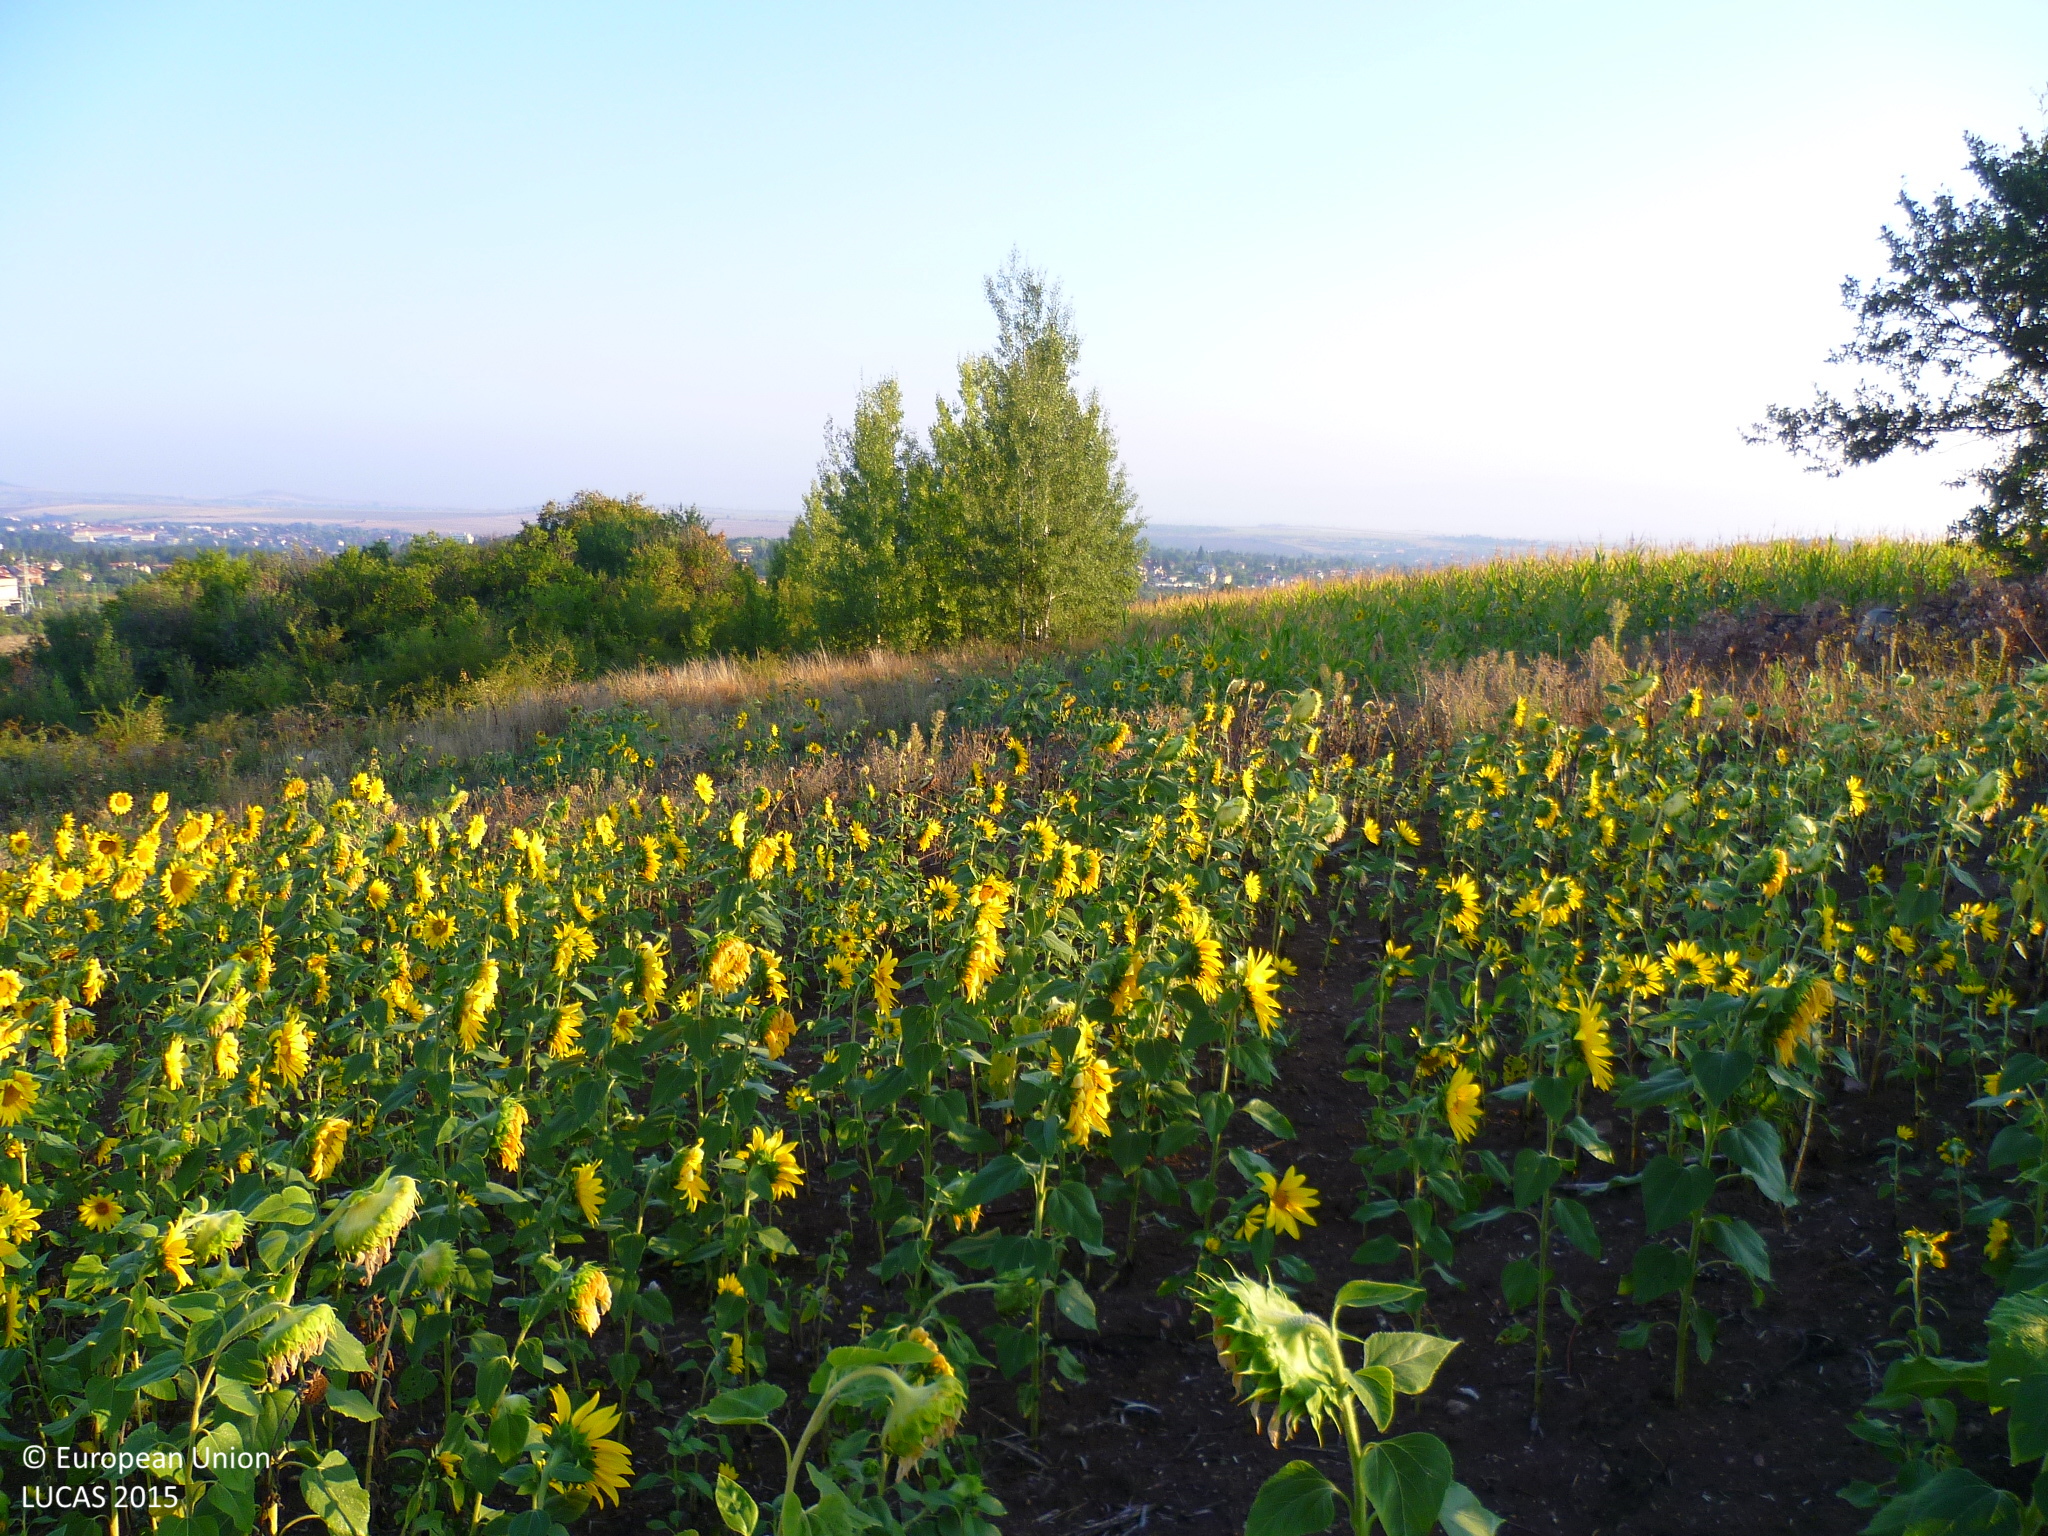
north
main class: Cropland
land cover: Sunflower
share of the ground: > 75 %
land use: Agriculture (excluding fallow land and kitchen gardens)
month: September
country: BG
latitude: 42.6875
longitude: 23.1522
